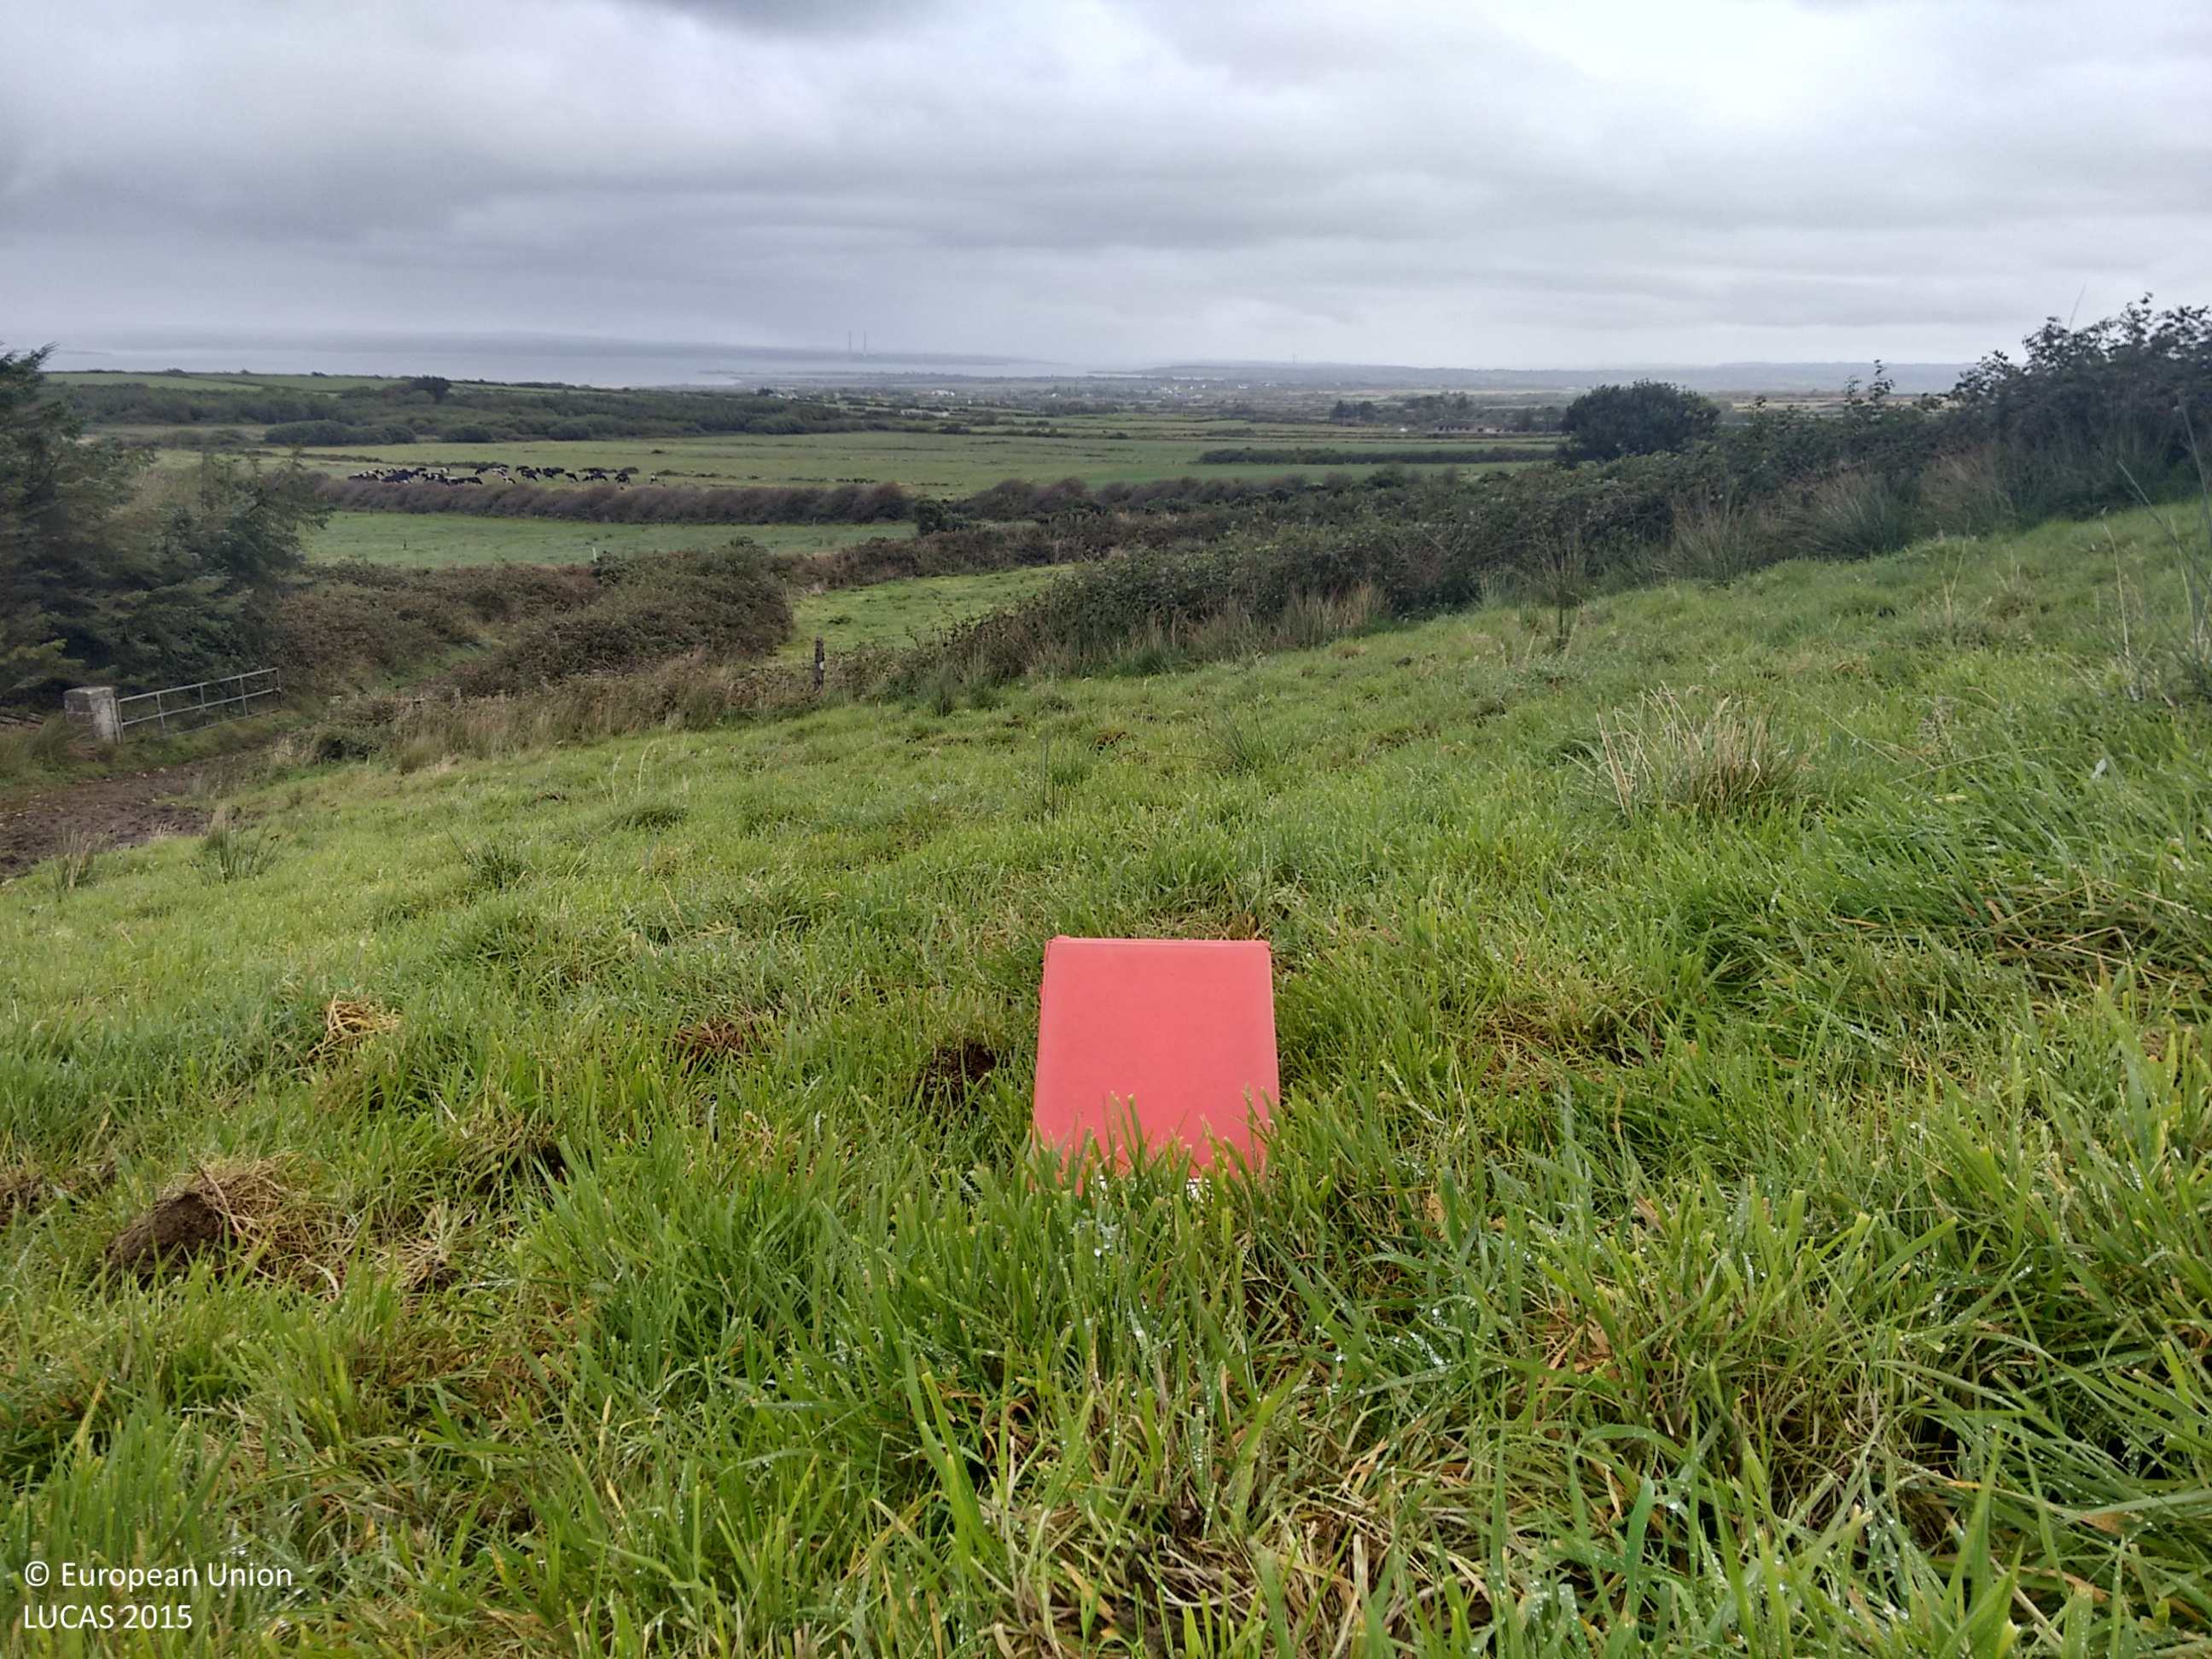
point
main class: Grassland
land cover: Grassland without tree/shrub cover
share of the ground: > 75 %
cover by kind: herbaceous plants 95 %, shrubs 5 %
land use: Agriculture (excluding fallow land and kitchen gardens)
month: September
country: IE
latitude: 52.5368
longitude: -9.5947
